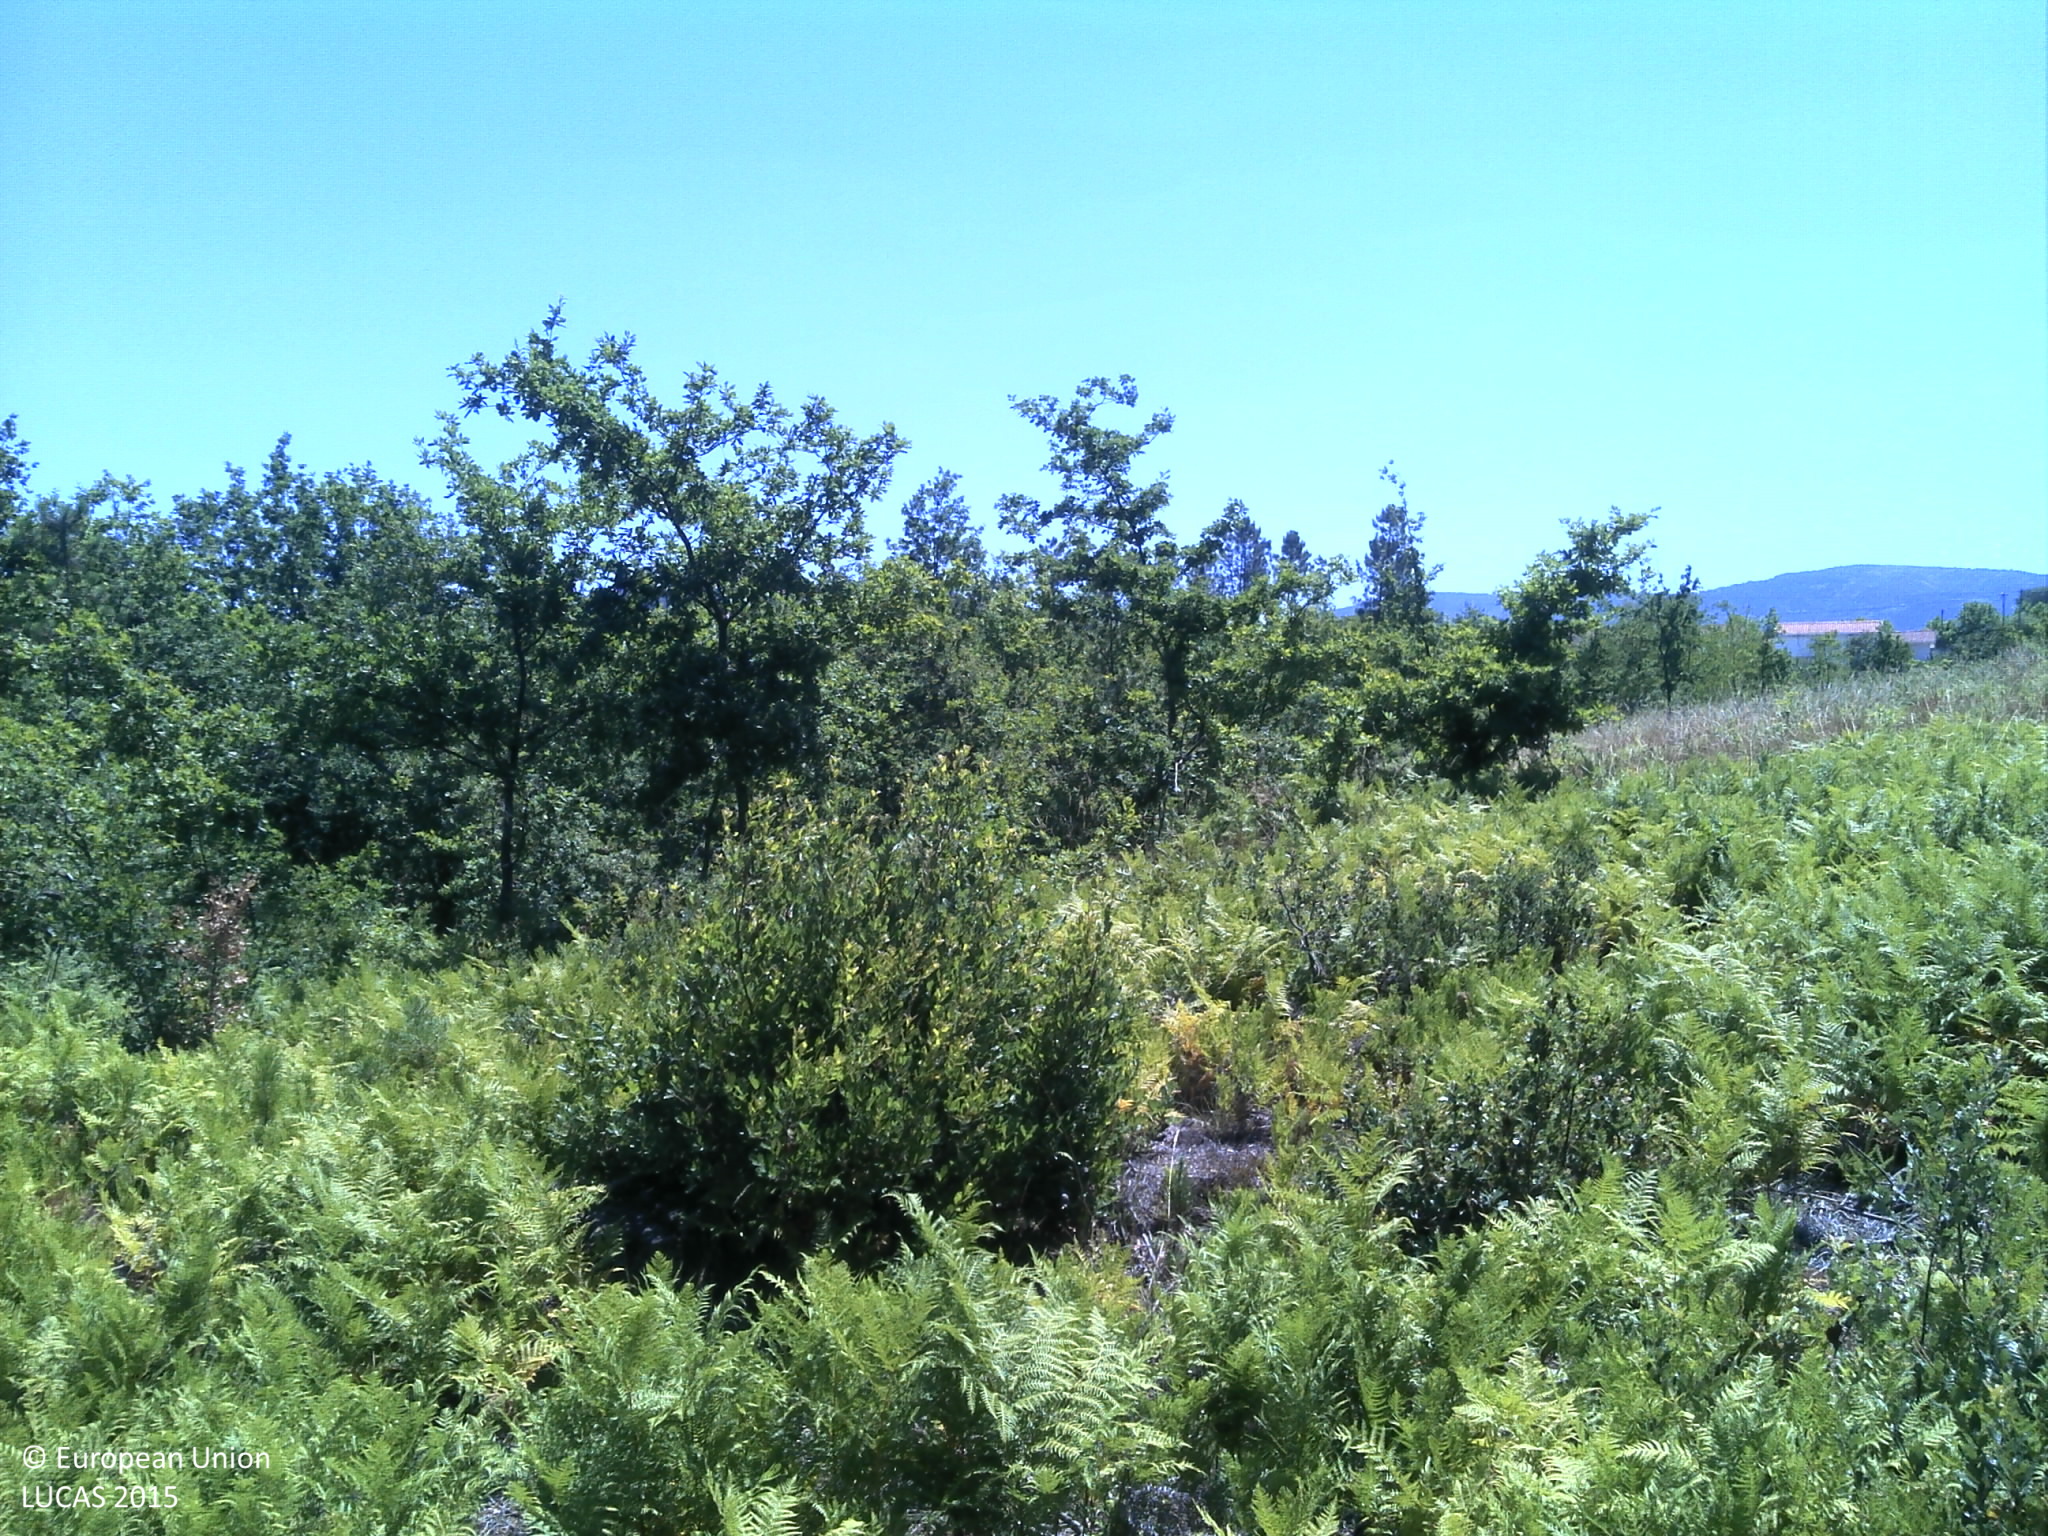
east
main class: Grassland
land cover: Grassland with sparse tree/shrub cover
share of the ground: > 75 %
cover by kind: herbaceous plants 50 %, unconsolidated bare surface 40 %, broadleaved forest trees 5 %, shrubs 5 %
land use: Forestry
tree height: < 5 m
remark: Clear cut
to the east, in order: Grassland with sparse tree/shrub cover; Broadleaved woodland; Spontaneously vegetated surfaces; Broadleaved woodland; Pine dominated coniferous woodland; Electric lines; Broadleaved woodland
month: July
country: PT
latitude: 40.2717
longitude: -7.9829
